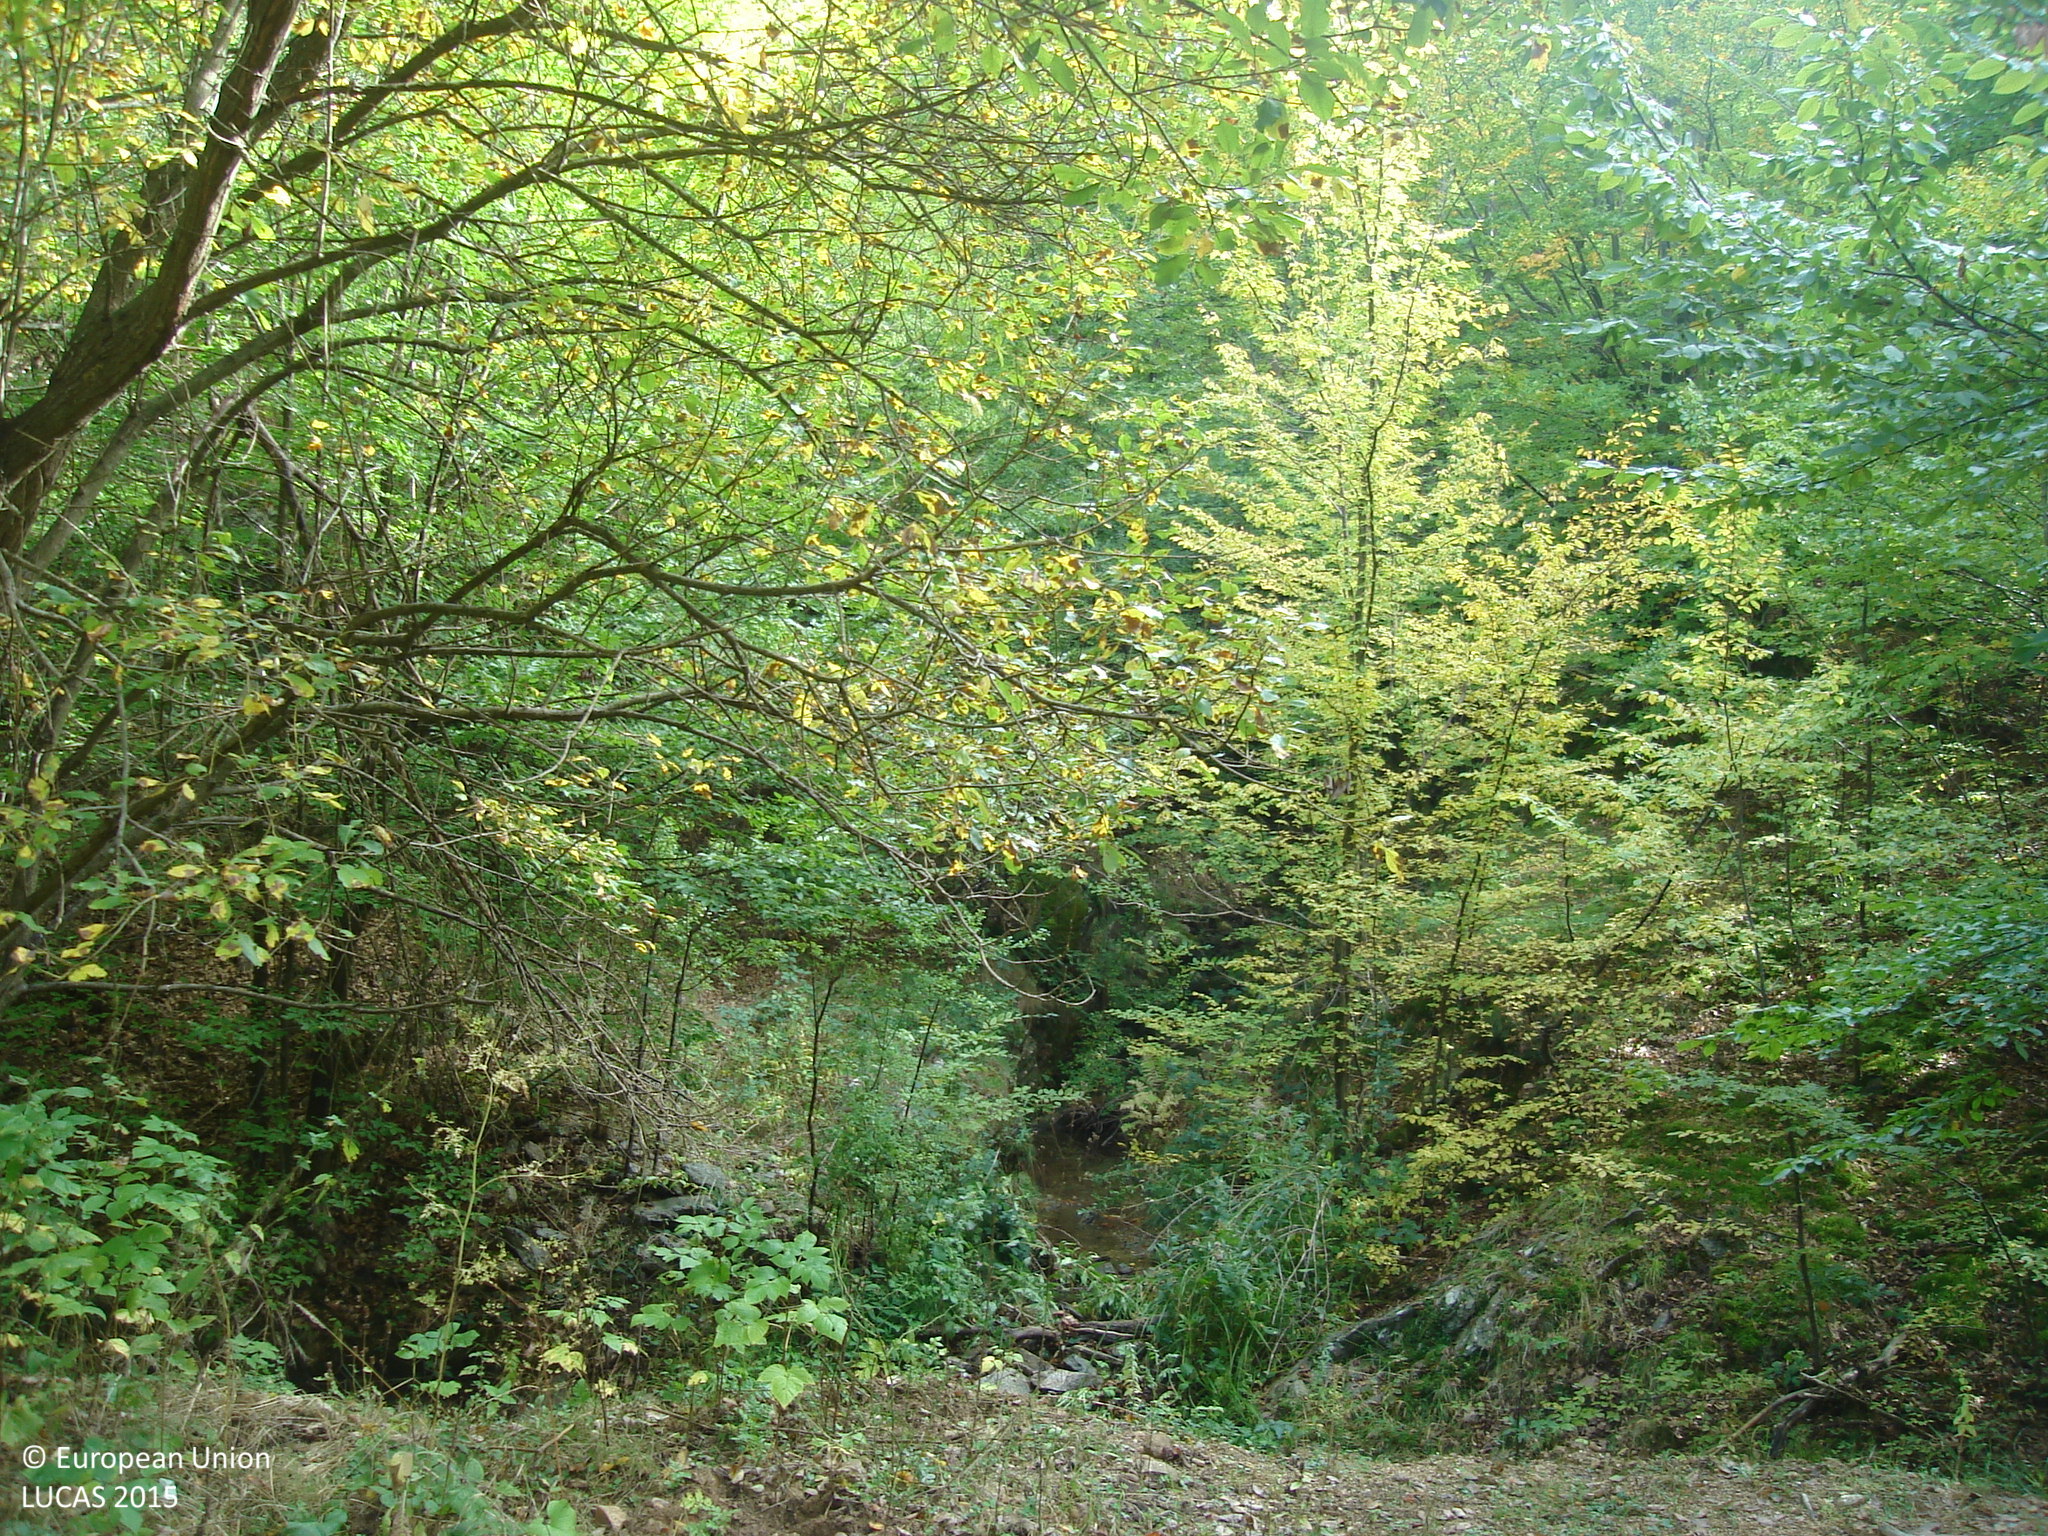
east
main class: Woodland
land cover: Broadleaved woodland
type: mesophytic deciduous forest
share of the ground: > 75 %
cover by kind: broadleaved forest trees 100 %
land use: Forestry
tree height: > 5 m
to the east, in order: Broadleaved woodland
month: October
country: BG
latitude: 42.5795
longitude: 23.8207
